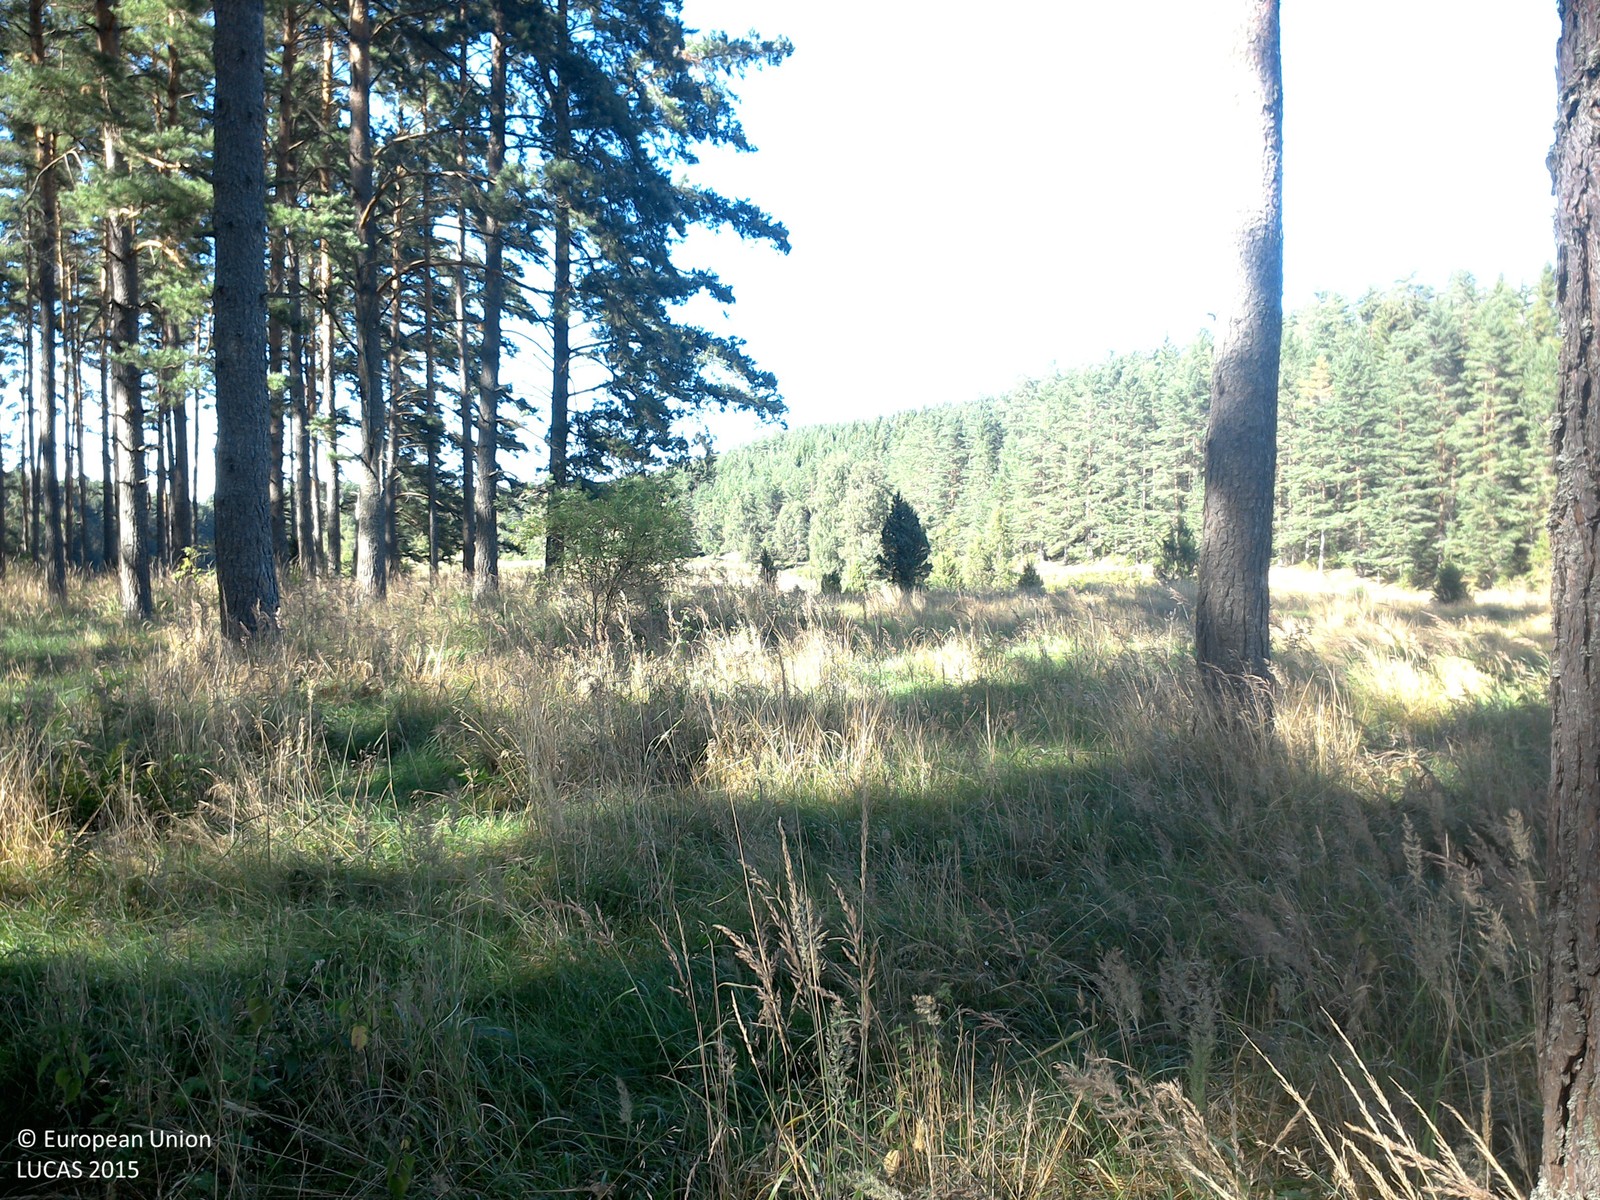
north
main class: Woodland
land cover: Pine dominated coniferous woodland
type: boreal forest
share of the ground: 50 - 75 %
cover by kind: coniferous forest trees 60 %, herbaceous plants 40 %
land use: Agriculture (excluding fallow land and kitchen gardens)
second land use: Forestry
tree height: > 5 m
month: August
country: SE
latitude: 58.0816
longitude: 15.2349
